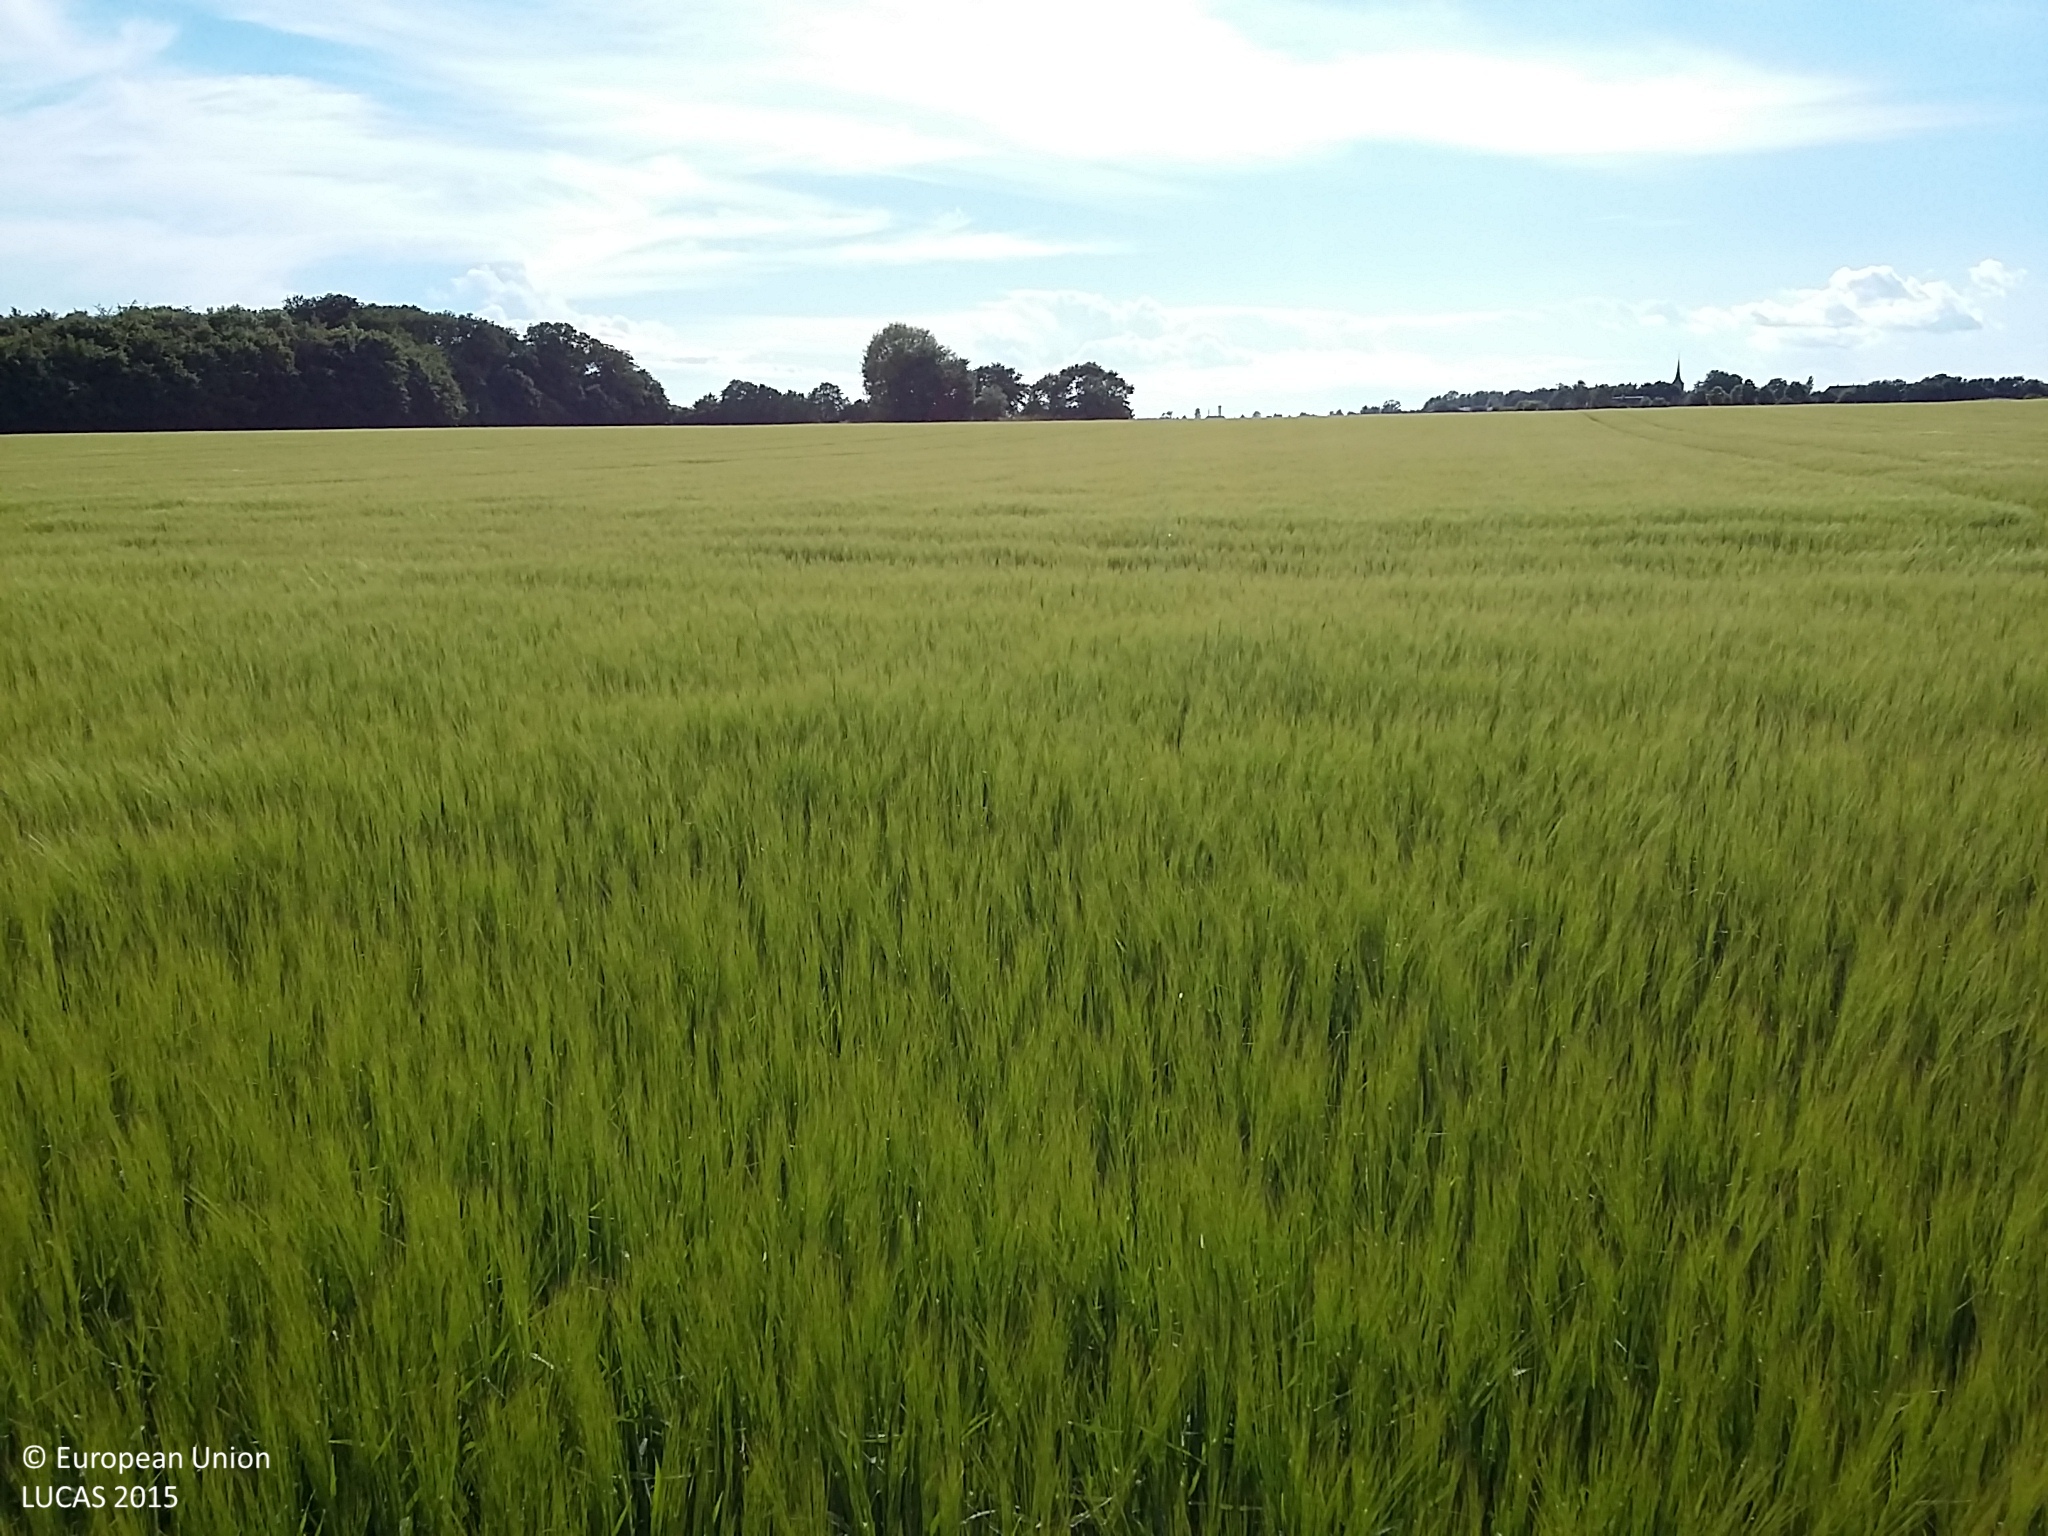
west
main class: Cropland
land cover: Barley
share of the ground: > 75 %
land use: Agriculture (excluding fallow land and kitchen gardens)
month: June
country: DK
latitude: 54.7044
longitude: 11.5354
